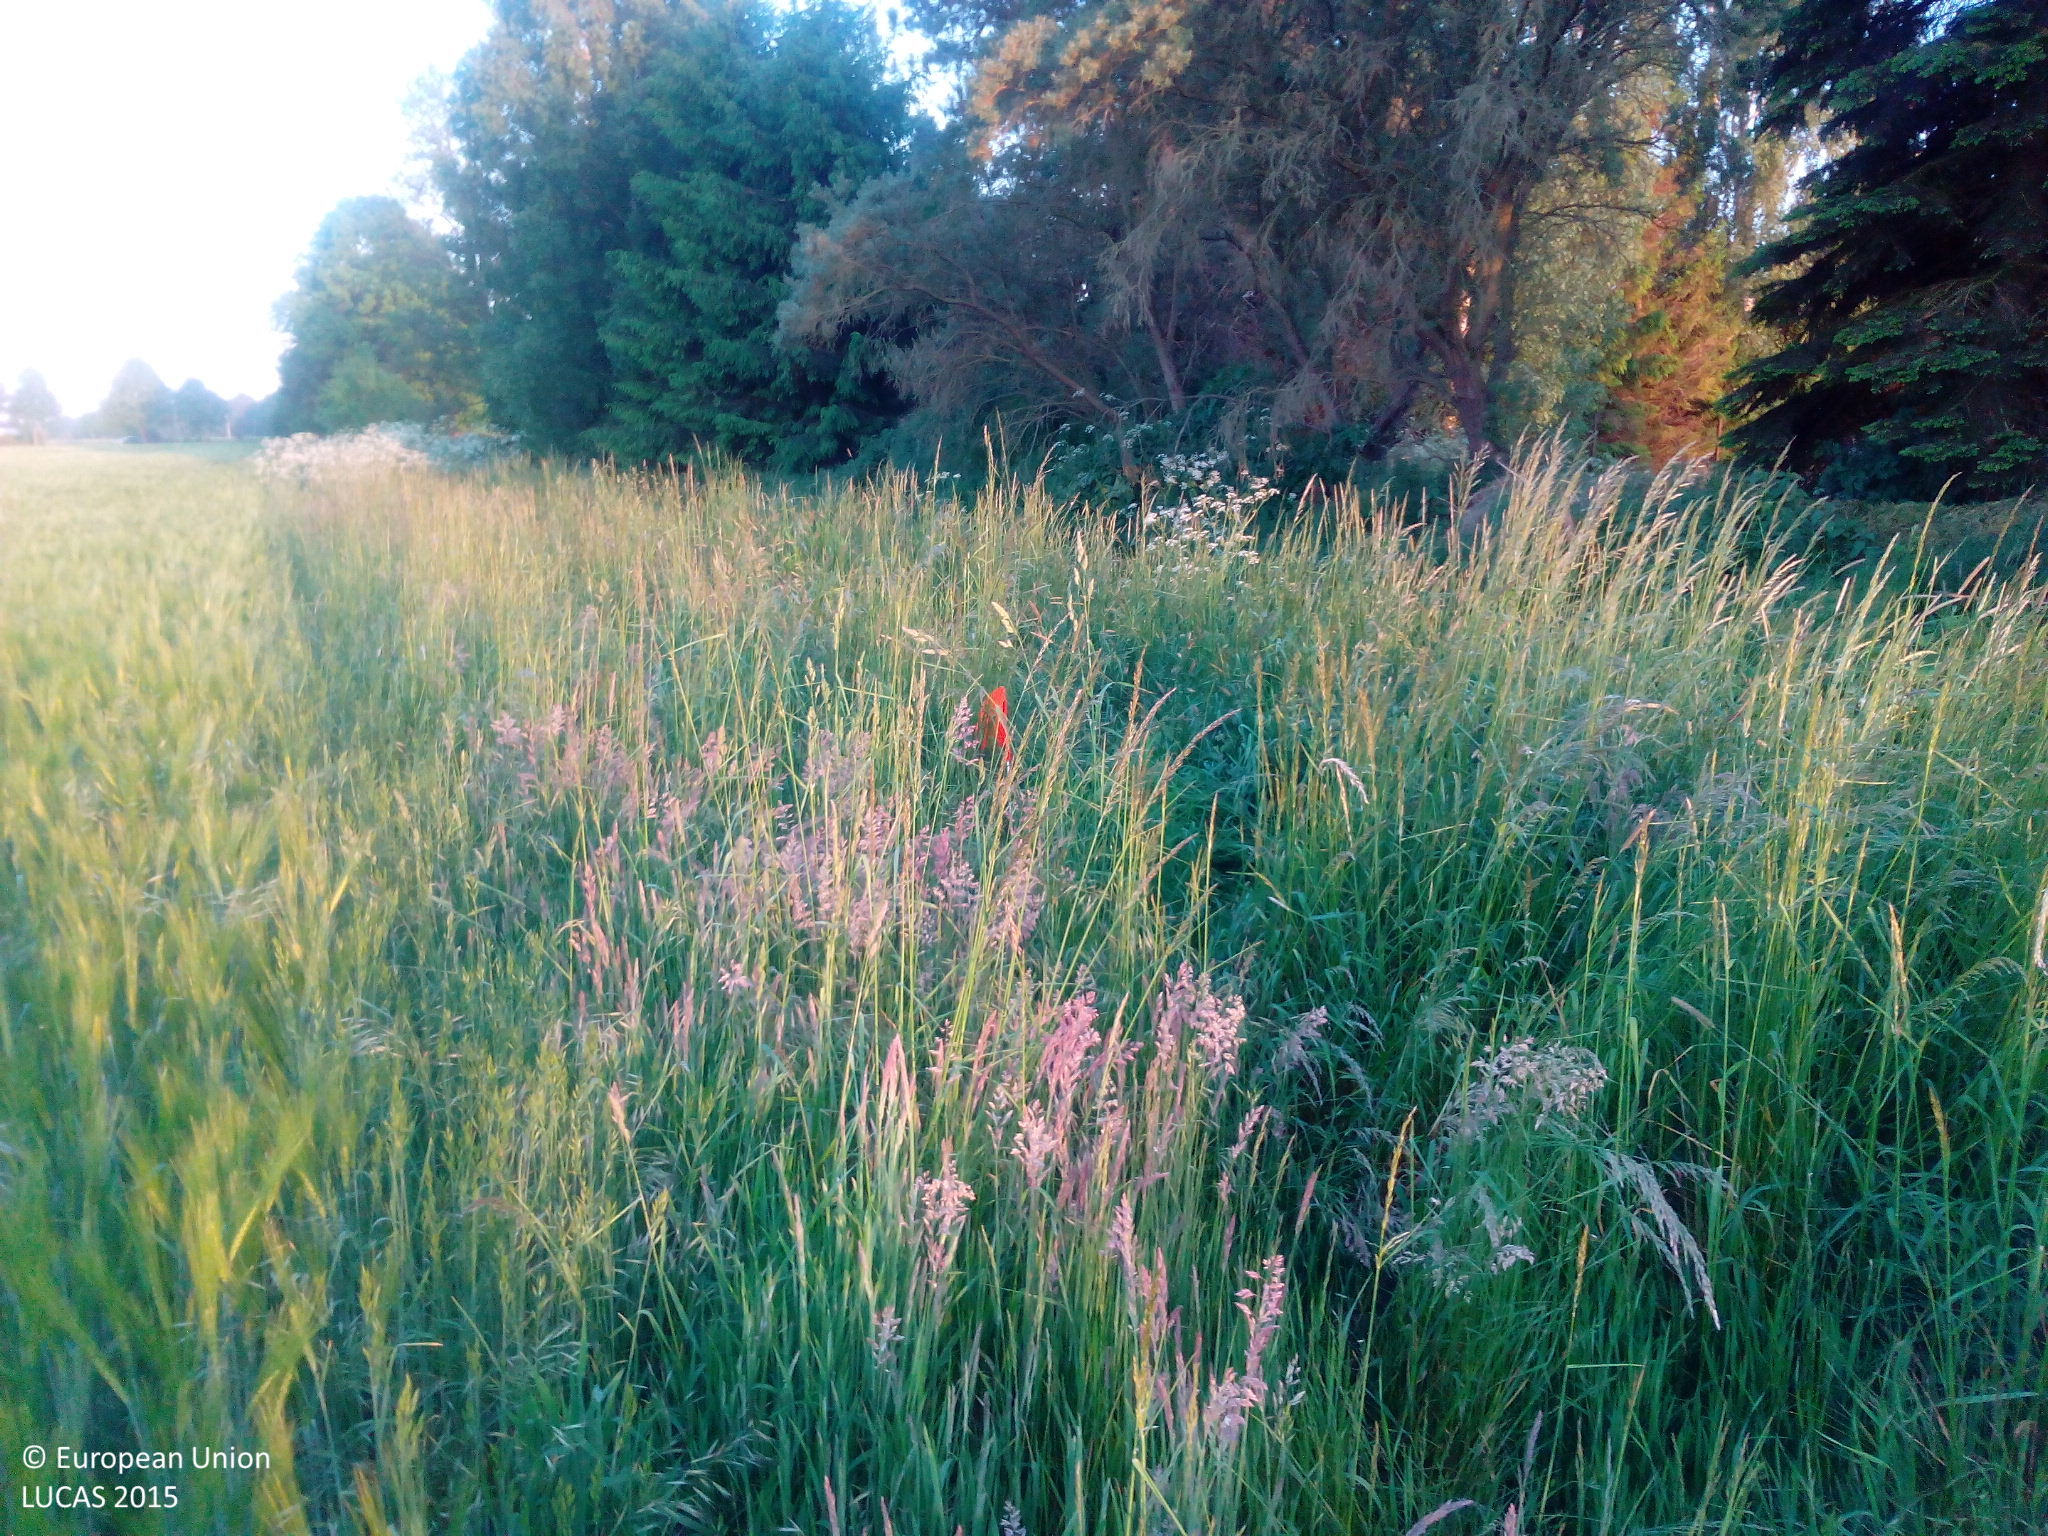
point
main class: Grassland
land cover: Grassland without tree/shrub cover
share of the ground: > 75 %
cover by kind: herbaceous plants 100 %
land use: Semi-natural and natural areas not in use
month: June
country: DE
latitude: 53.2850
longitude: 11.4844
